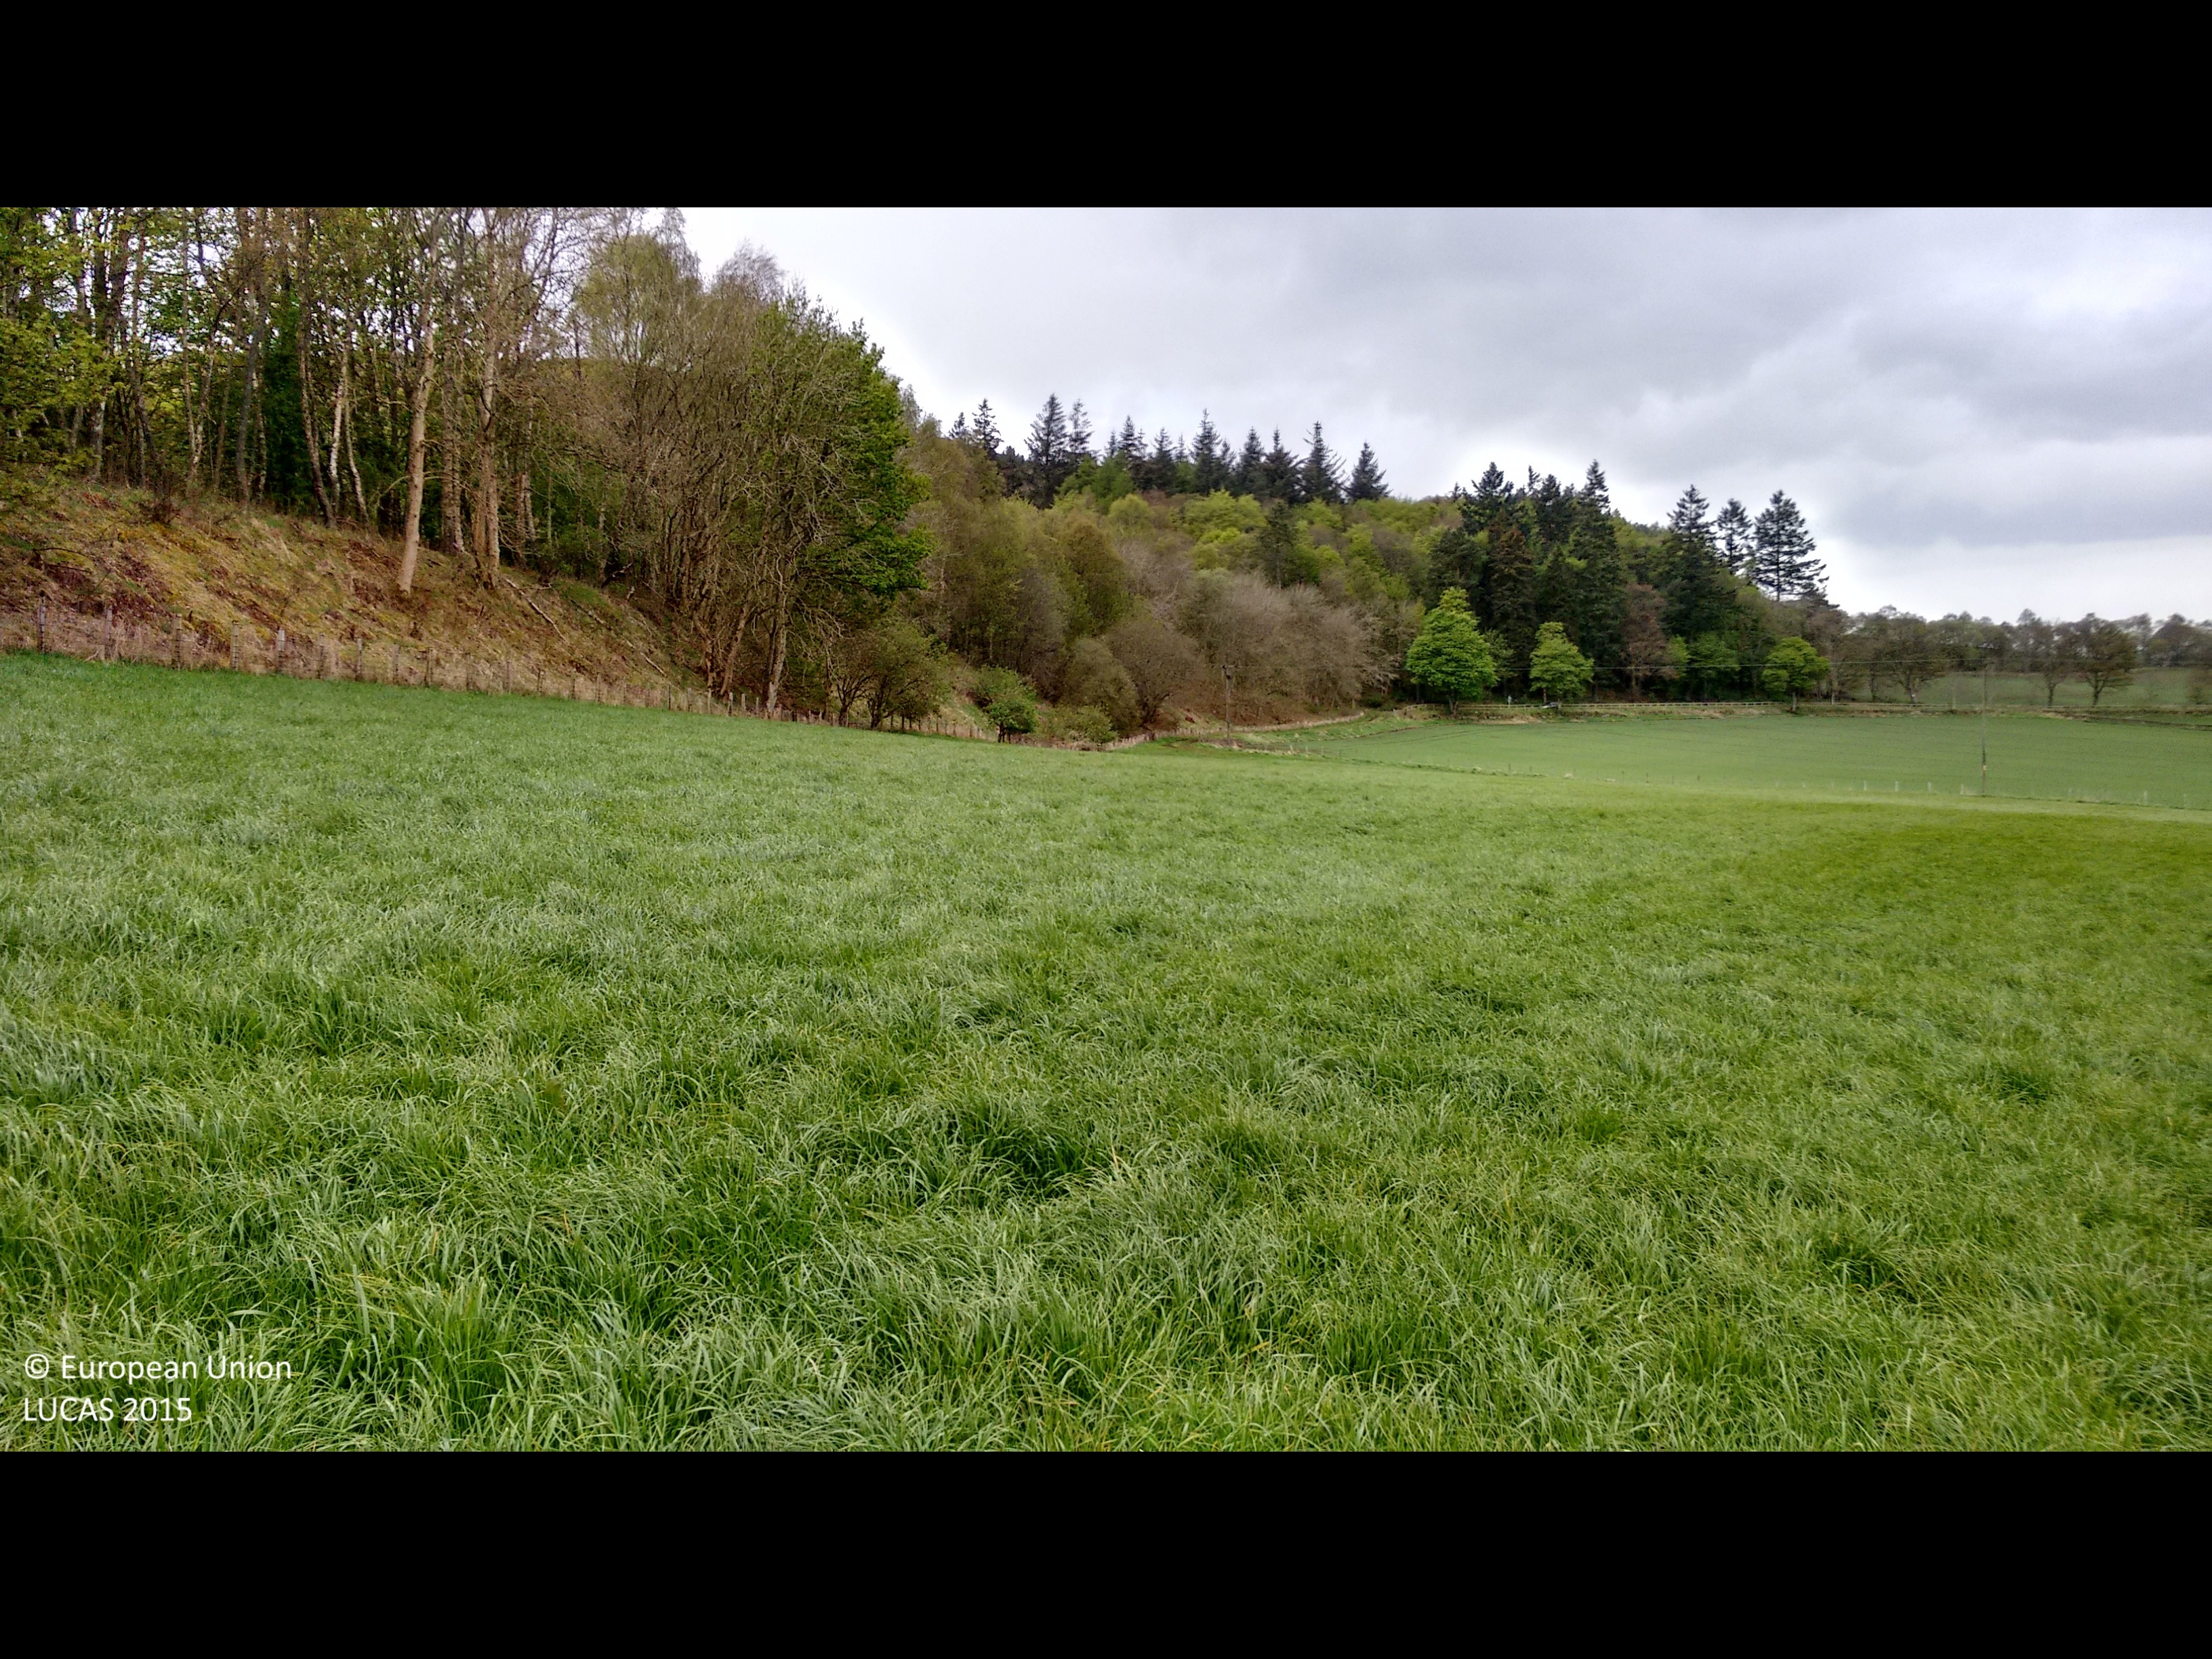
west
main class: Cropland
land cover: Temporary grasslands
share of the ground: > 75 %
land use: Agriculture (excluding fallow land and kitchen gardens)
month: May
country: GB
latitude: 56.5493
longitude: -3.1299
